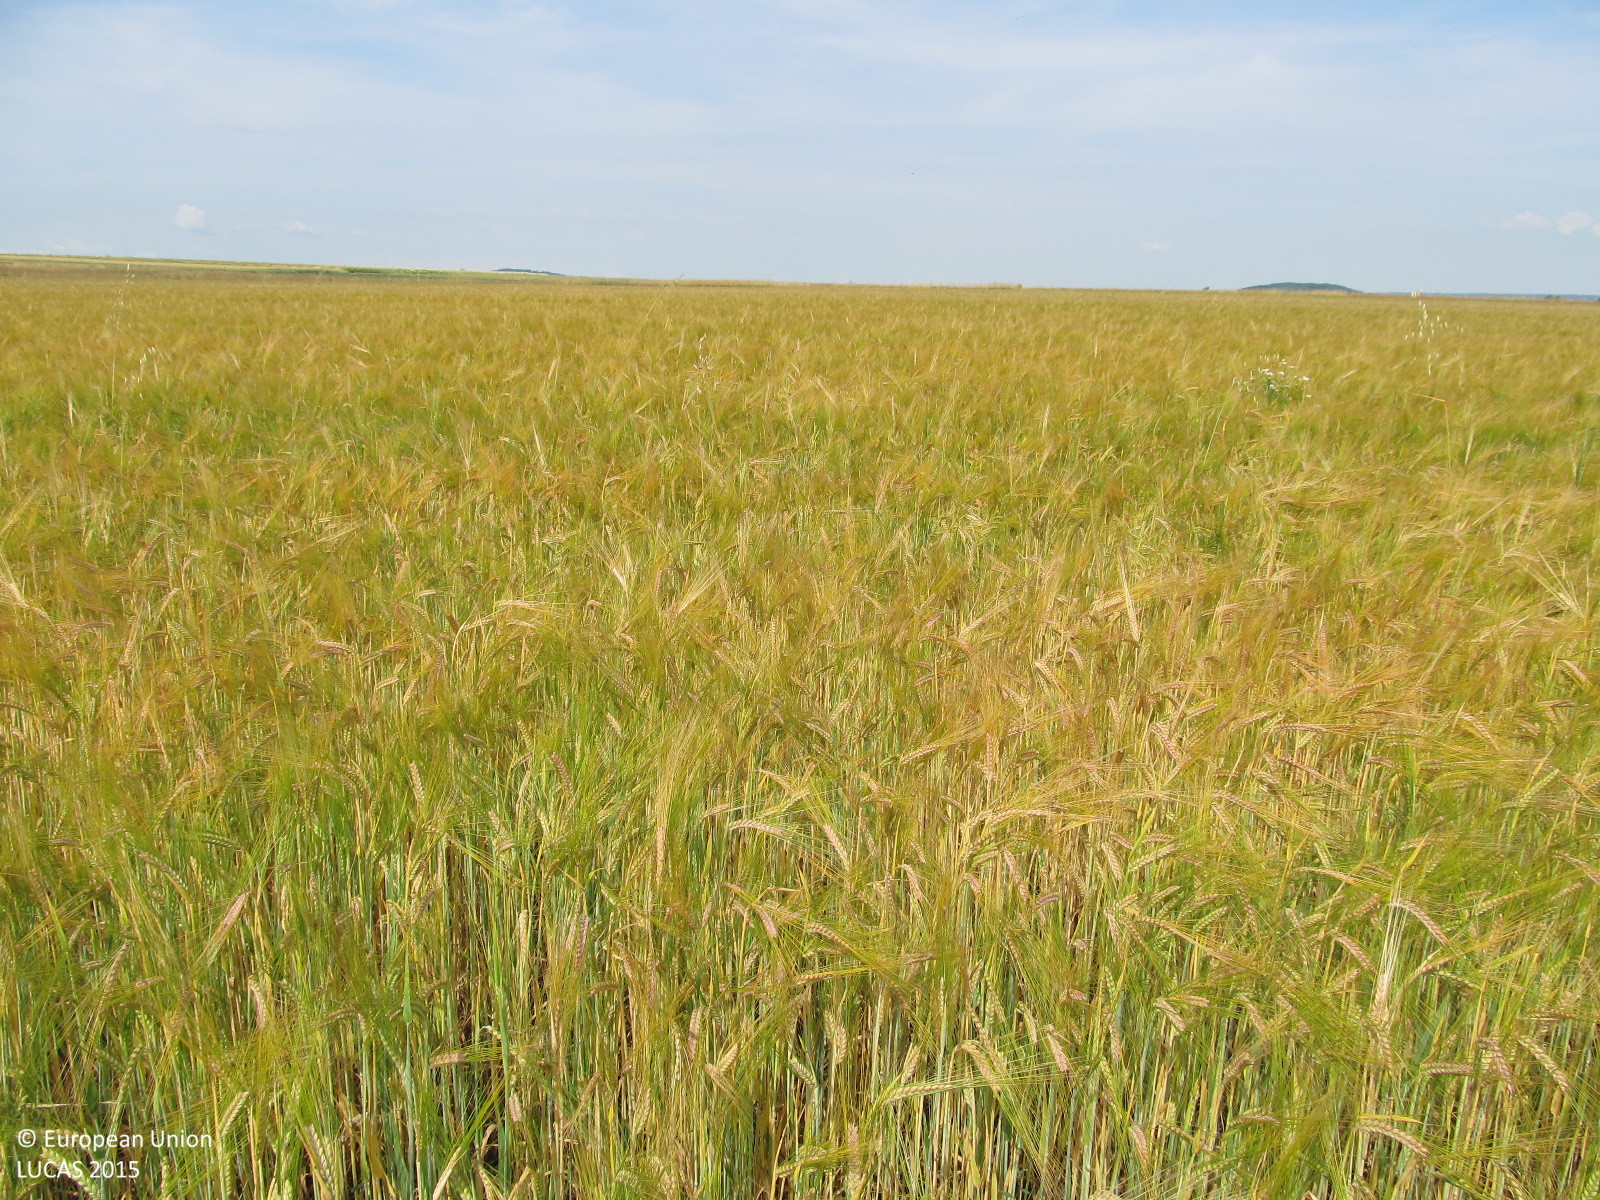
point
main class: Cropland
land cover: Barley
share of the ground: > 75 %
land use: Agriculture (excluding fallow land and kitchen gardens)
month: June
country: AT
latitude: 48.6424
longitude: 15.9079
